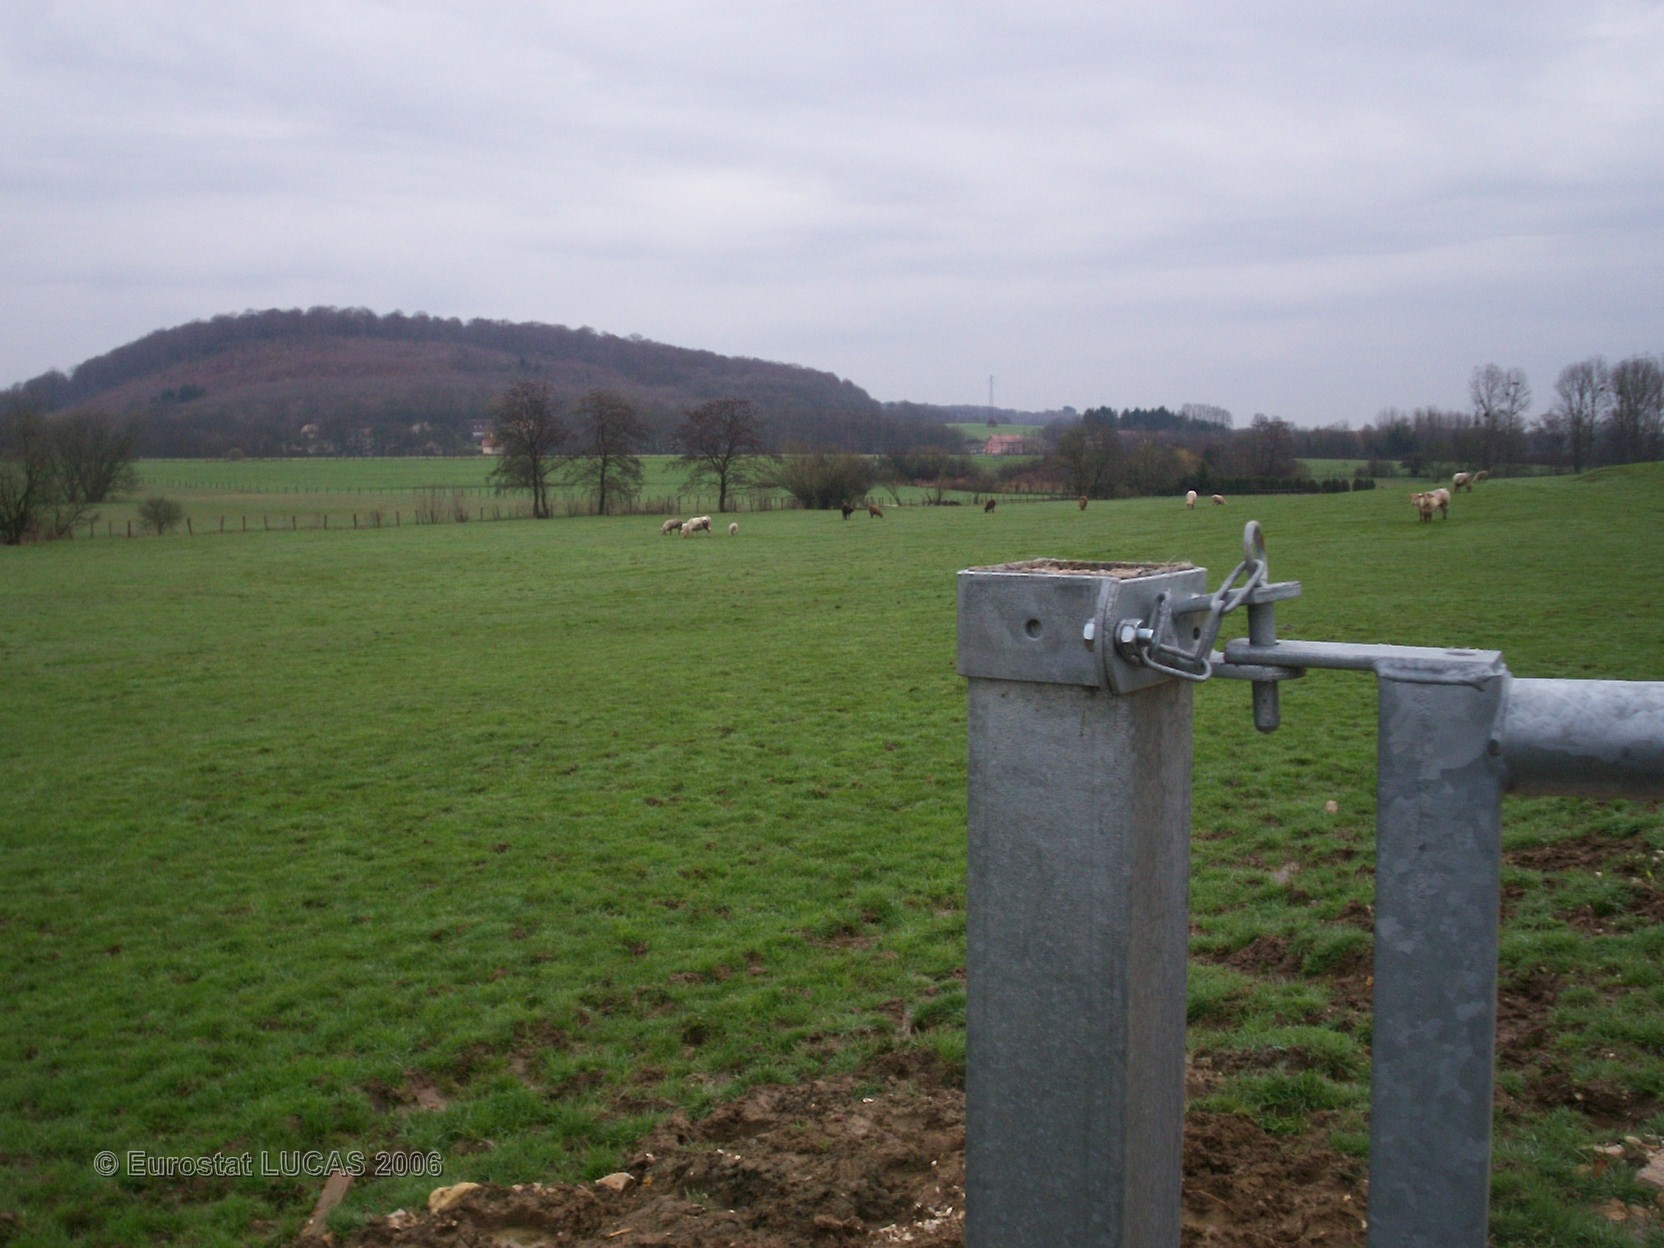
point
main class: Grassland
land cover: Grassland without tree/shrub cover
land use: Agriculture (excluding fallow land and kitchen gardens)
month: April
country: FR
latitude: 47.6366
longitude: 6.7939
